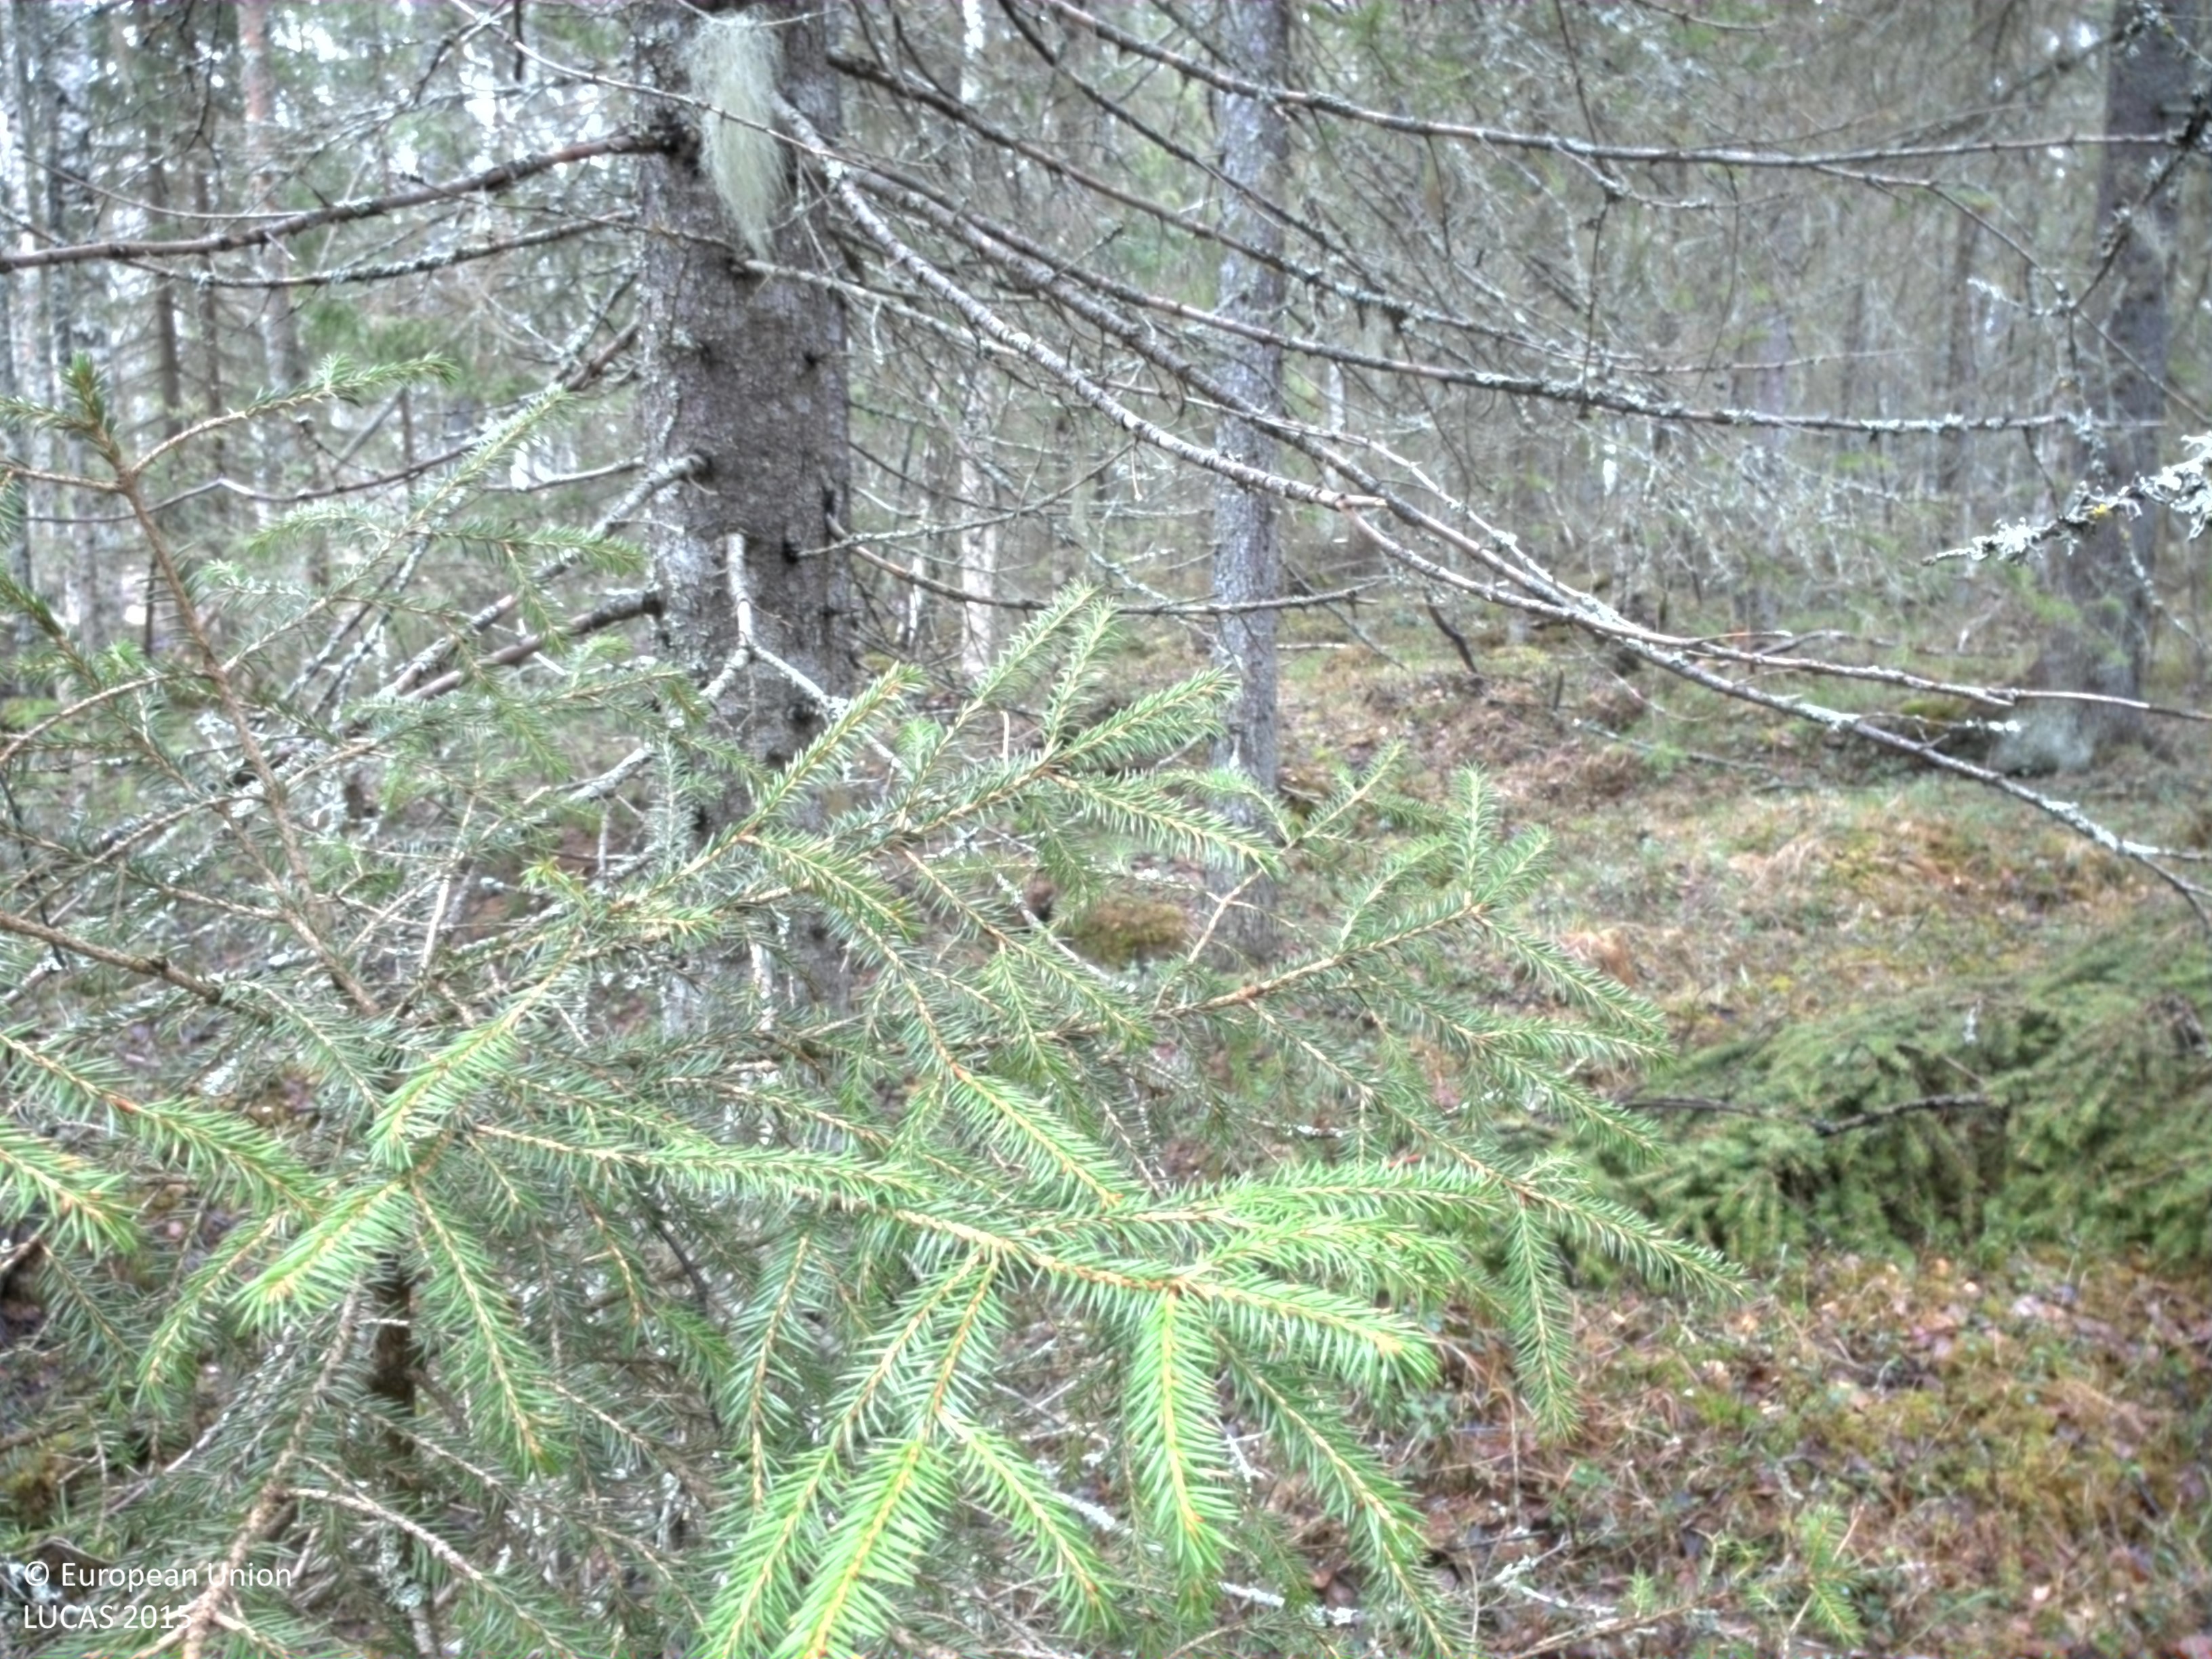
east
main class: Woodland
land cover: Spruce dominated mixed woodland
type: boreal forest
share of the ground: > 75 %
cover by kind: coniferous forest trees 60 %, broadleaved forest trees 20 %, lichens and mosses 15 %, shrubs 5 %
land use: Forestry
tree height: > 5 m
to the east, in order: Spruce dominated mixed woodland; Broadleaved woodland; Spruce dominated mixed woodland; Broadleaved woodland
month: May
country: SE
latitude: 65.8890
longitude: 22.9060
